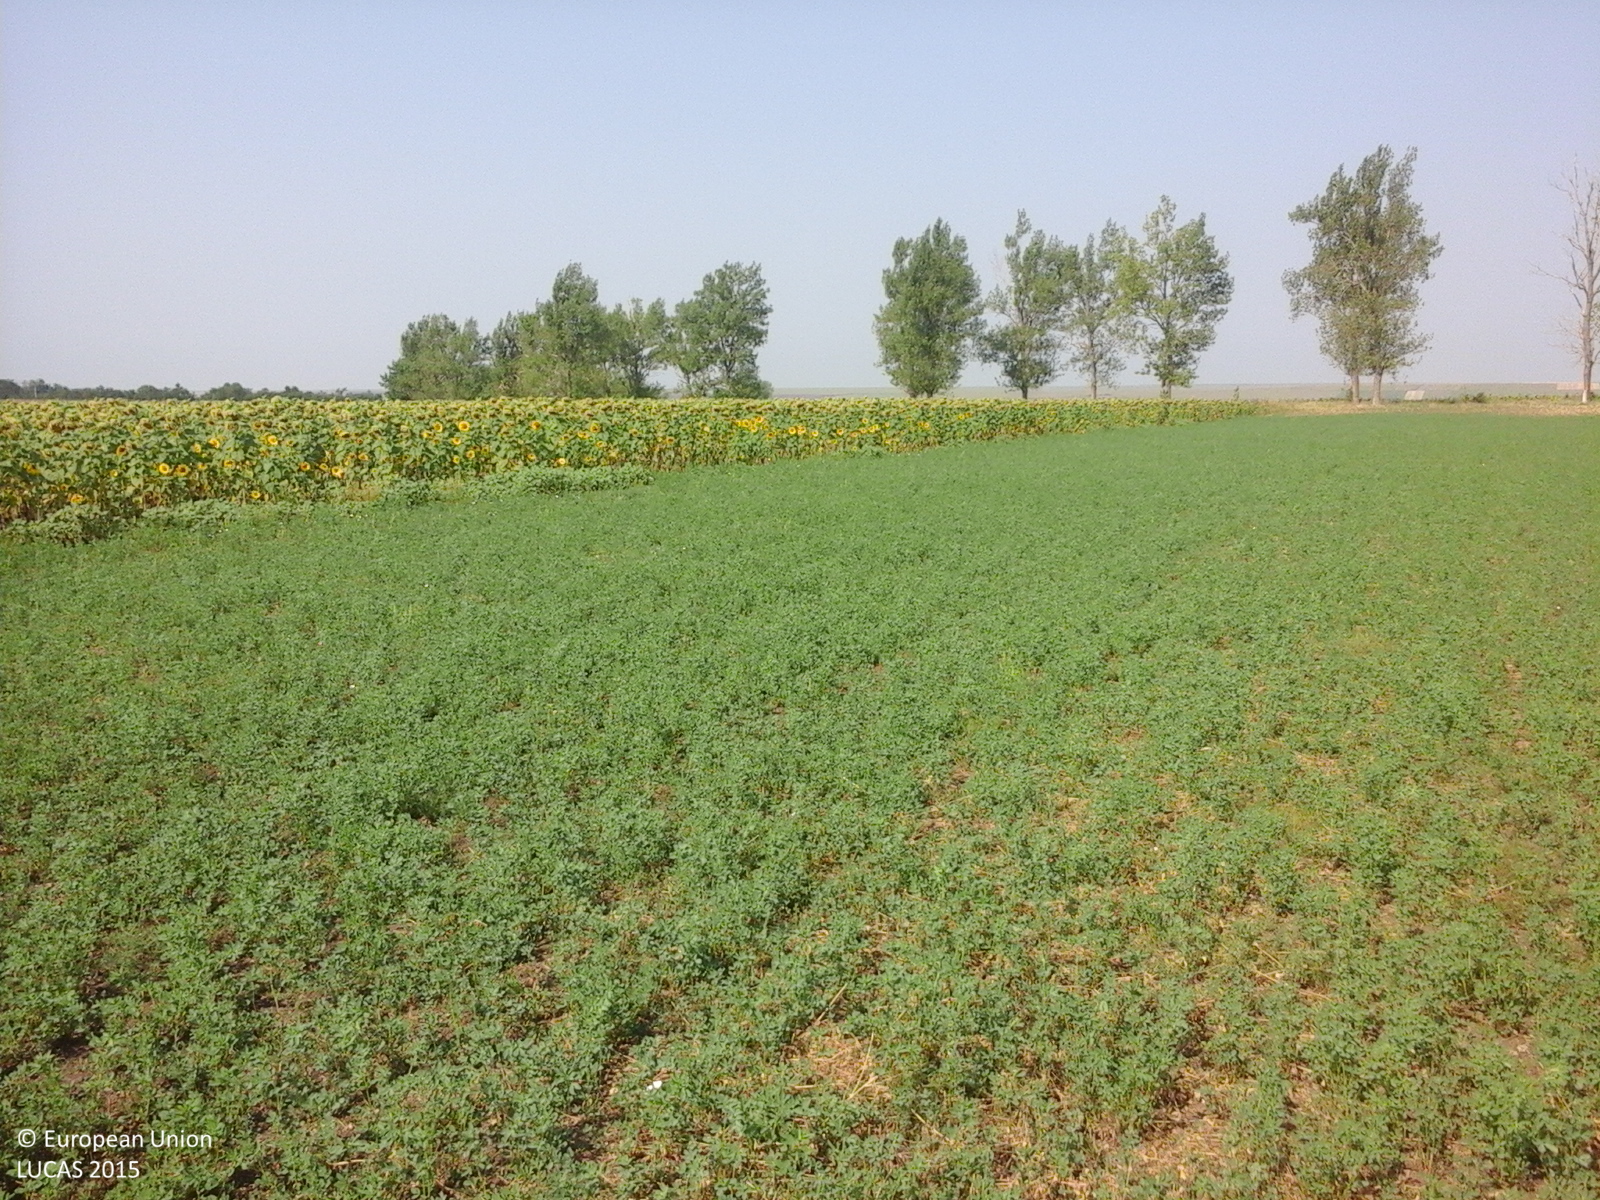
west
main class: Cropland
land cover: Lucerne
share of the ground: > 75 %
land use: Agriculture (excluding fallow land and kitchen gardens)
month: July
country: RO
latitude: 45.7173
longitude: 27.8571
